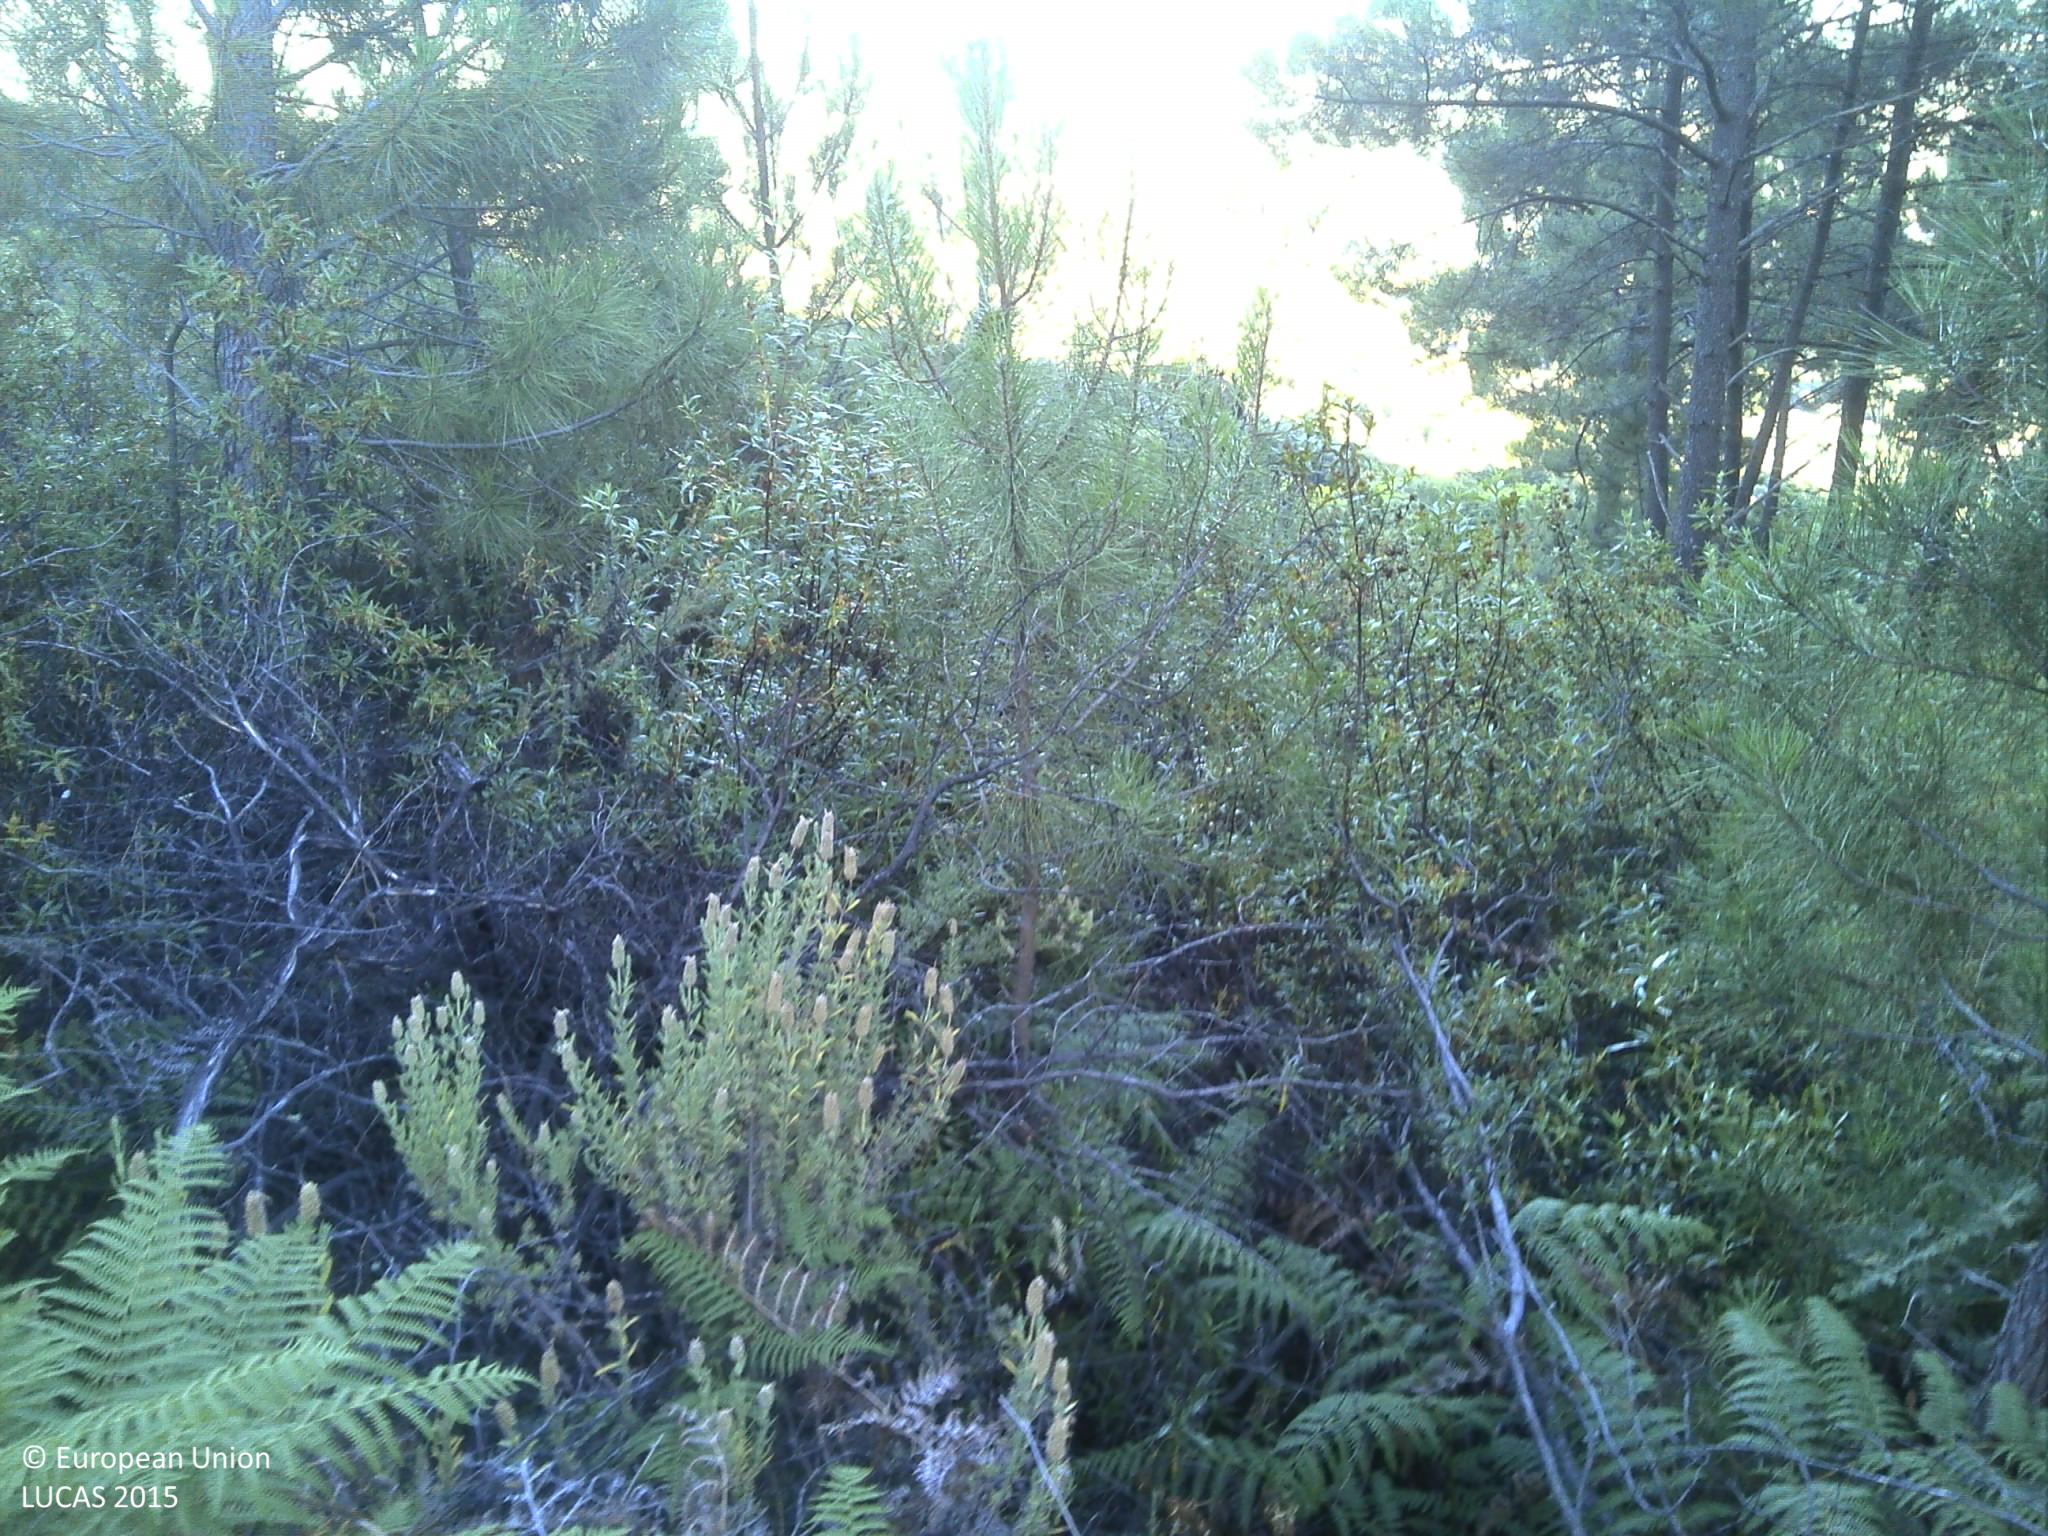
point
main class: Woodland
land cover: Pine dominated coniferous woodland
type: coniferous forest of the mediterranean region
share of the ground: 25 - 50 %
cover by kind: coniferous forest trees 50 %, shrubs 40 %, unconsolidated bare surface 5 %
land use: Forestry
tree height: > 5 m
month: June
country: PT
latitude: 40.1101
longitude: -7.4550
